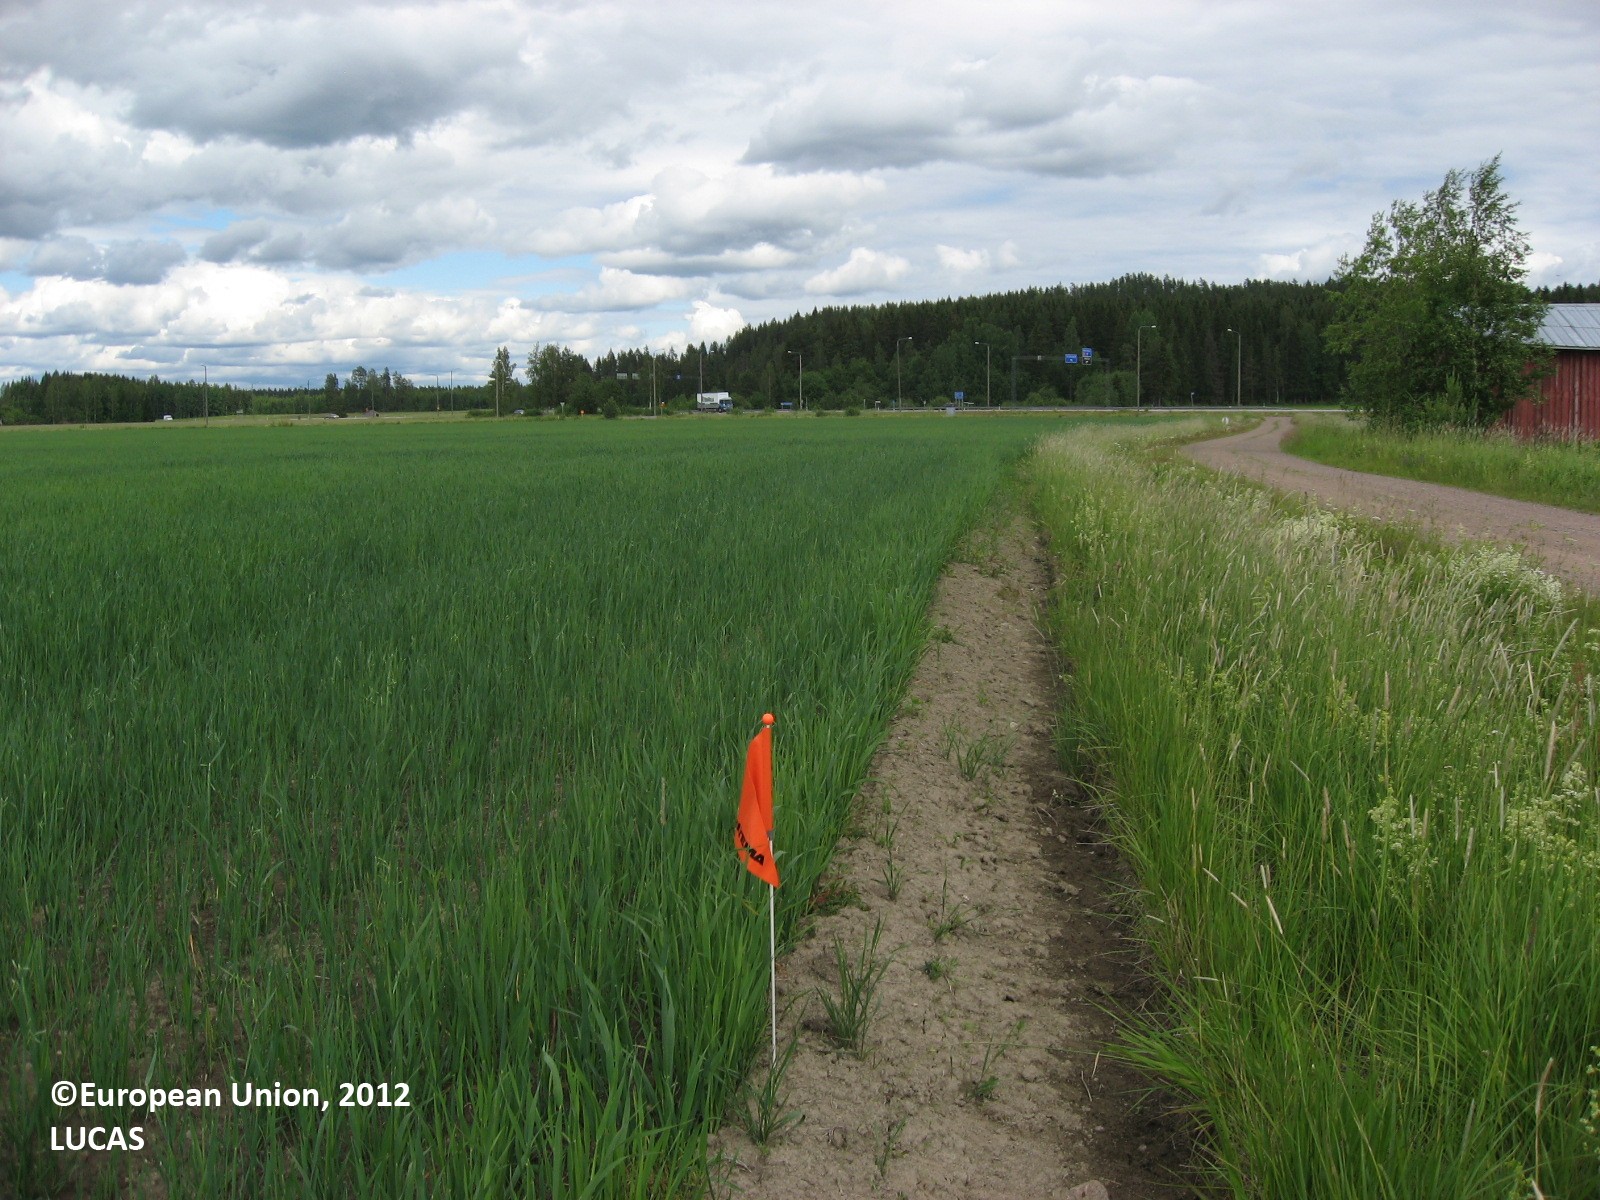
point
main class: Cropland
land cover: Oats
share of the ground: > 75 %
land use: Agriculture (excluding fallow land and kitchen gardens)
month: June
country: FI
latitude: 60.7707
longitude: 26.4739
